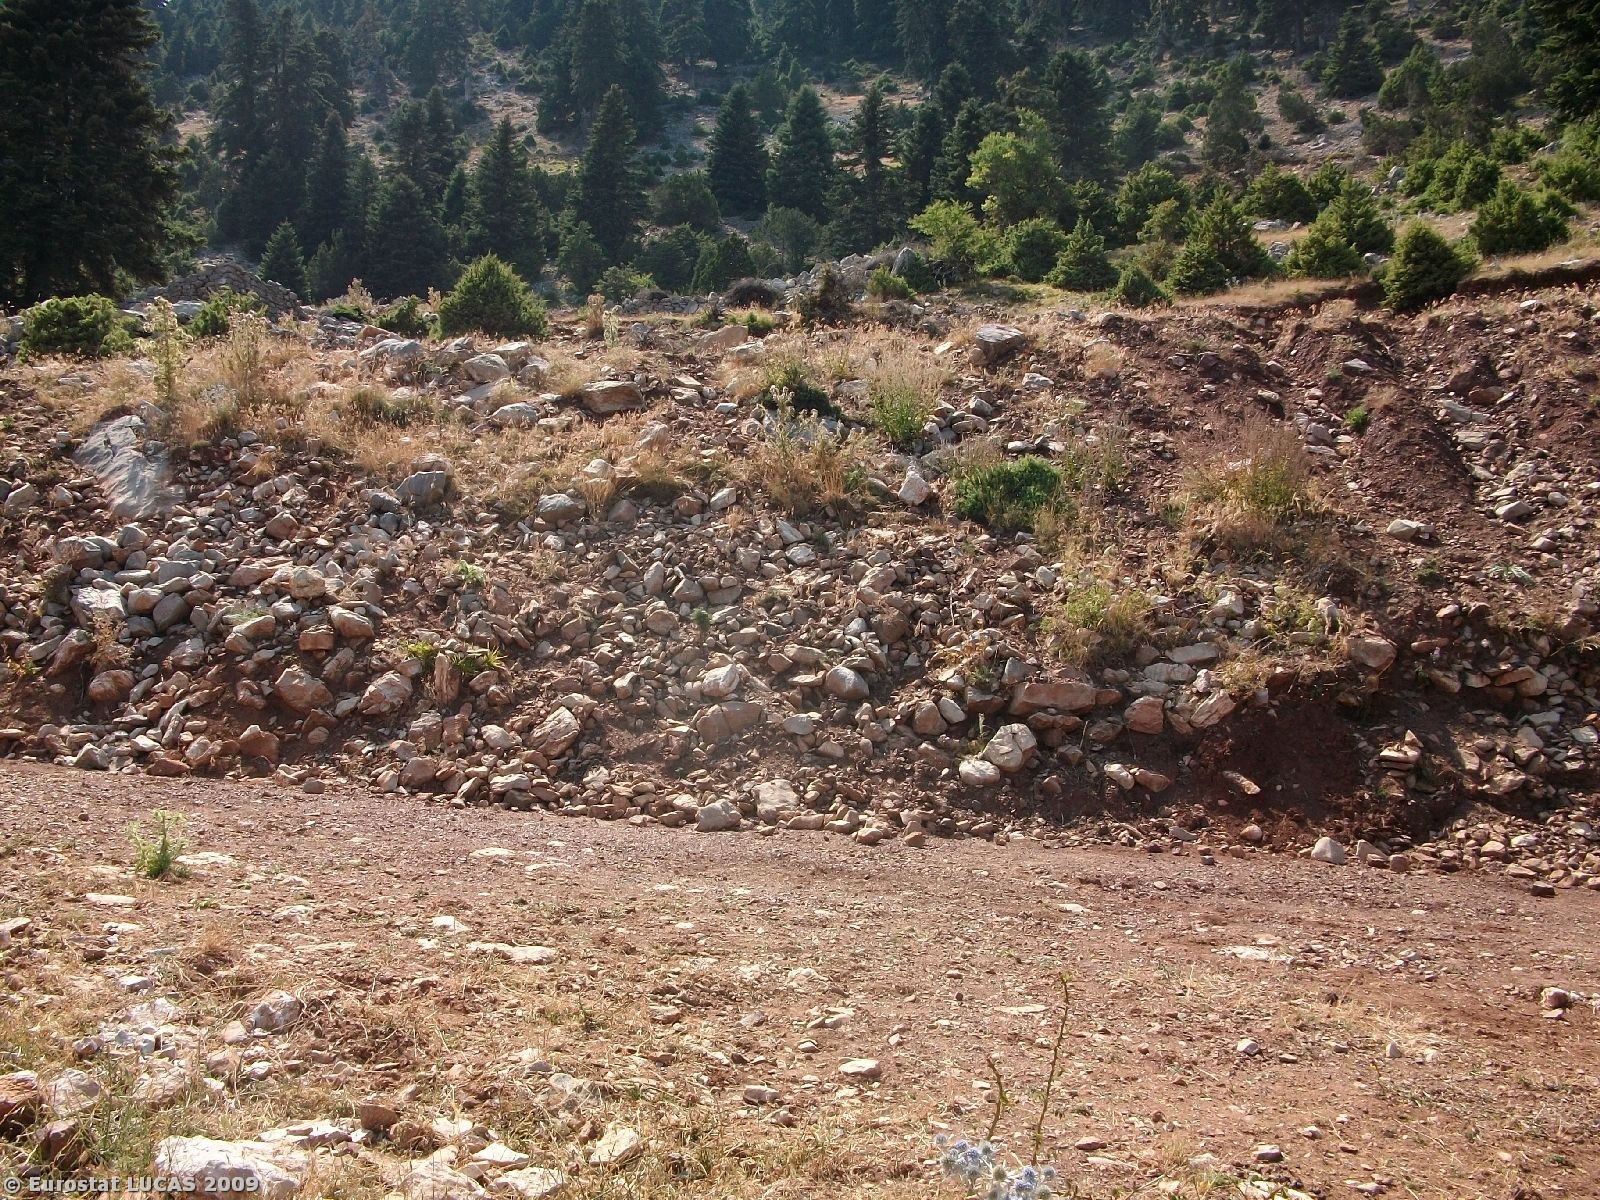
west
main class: Artificial land
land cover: Non built-up linear features
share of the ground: 50 - 75 %
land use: Water supply and treatment
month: August
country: GR
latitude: 39.0690
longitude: 21.5689
